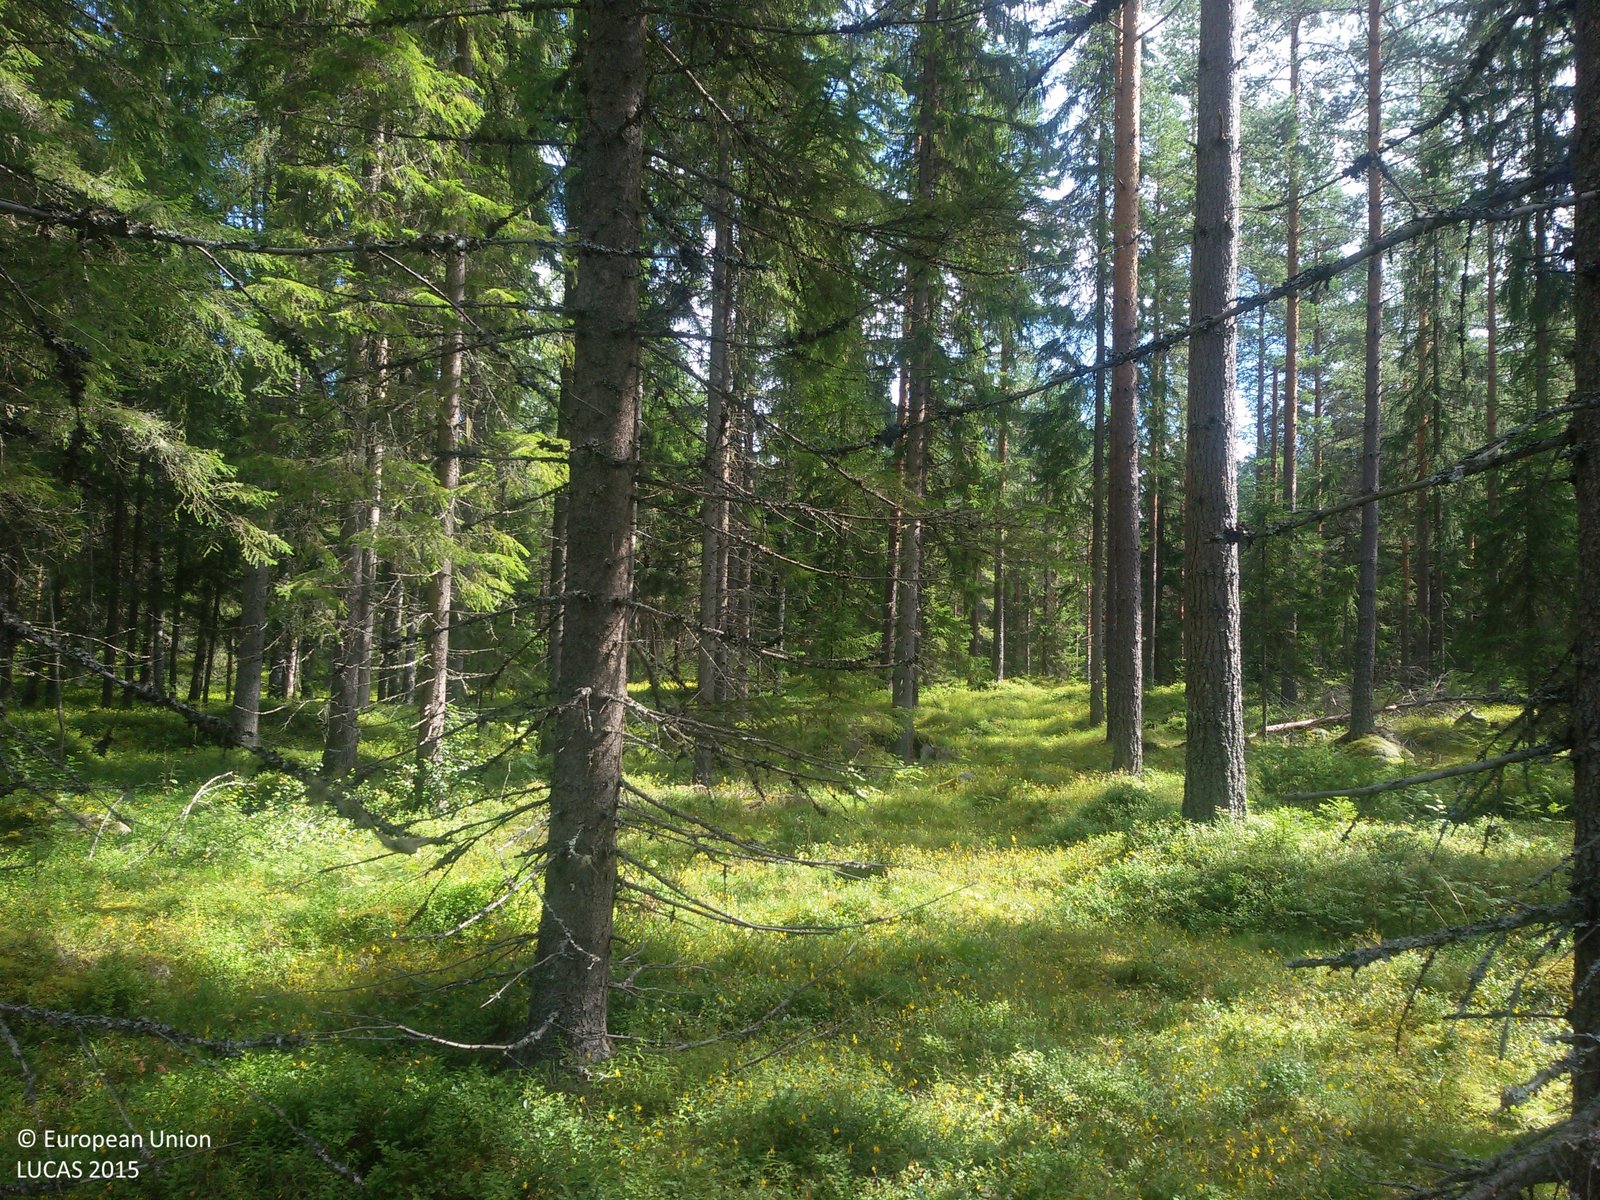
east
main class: Woodland
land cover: Spruce dominated coniferous woodland
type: boreal forest
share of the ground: 50 - 75 %
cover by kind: coniferous forest trees 70 %, herbaceous plants 15 %, lichens and mosses 15 %
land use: Forestry
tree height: > 5 m
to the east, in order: Spruce dominated coniferous woodland; Pine dominated coniferous woodland
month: August
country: SE
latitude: 60.7632
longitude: 16.6871
